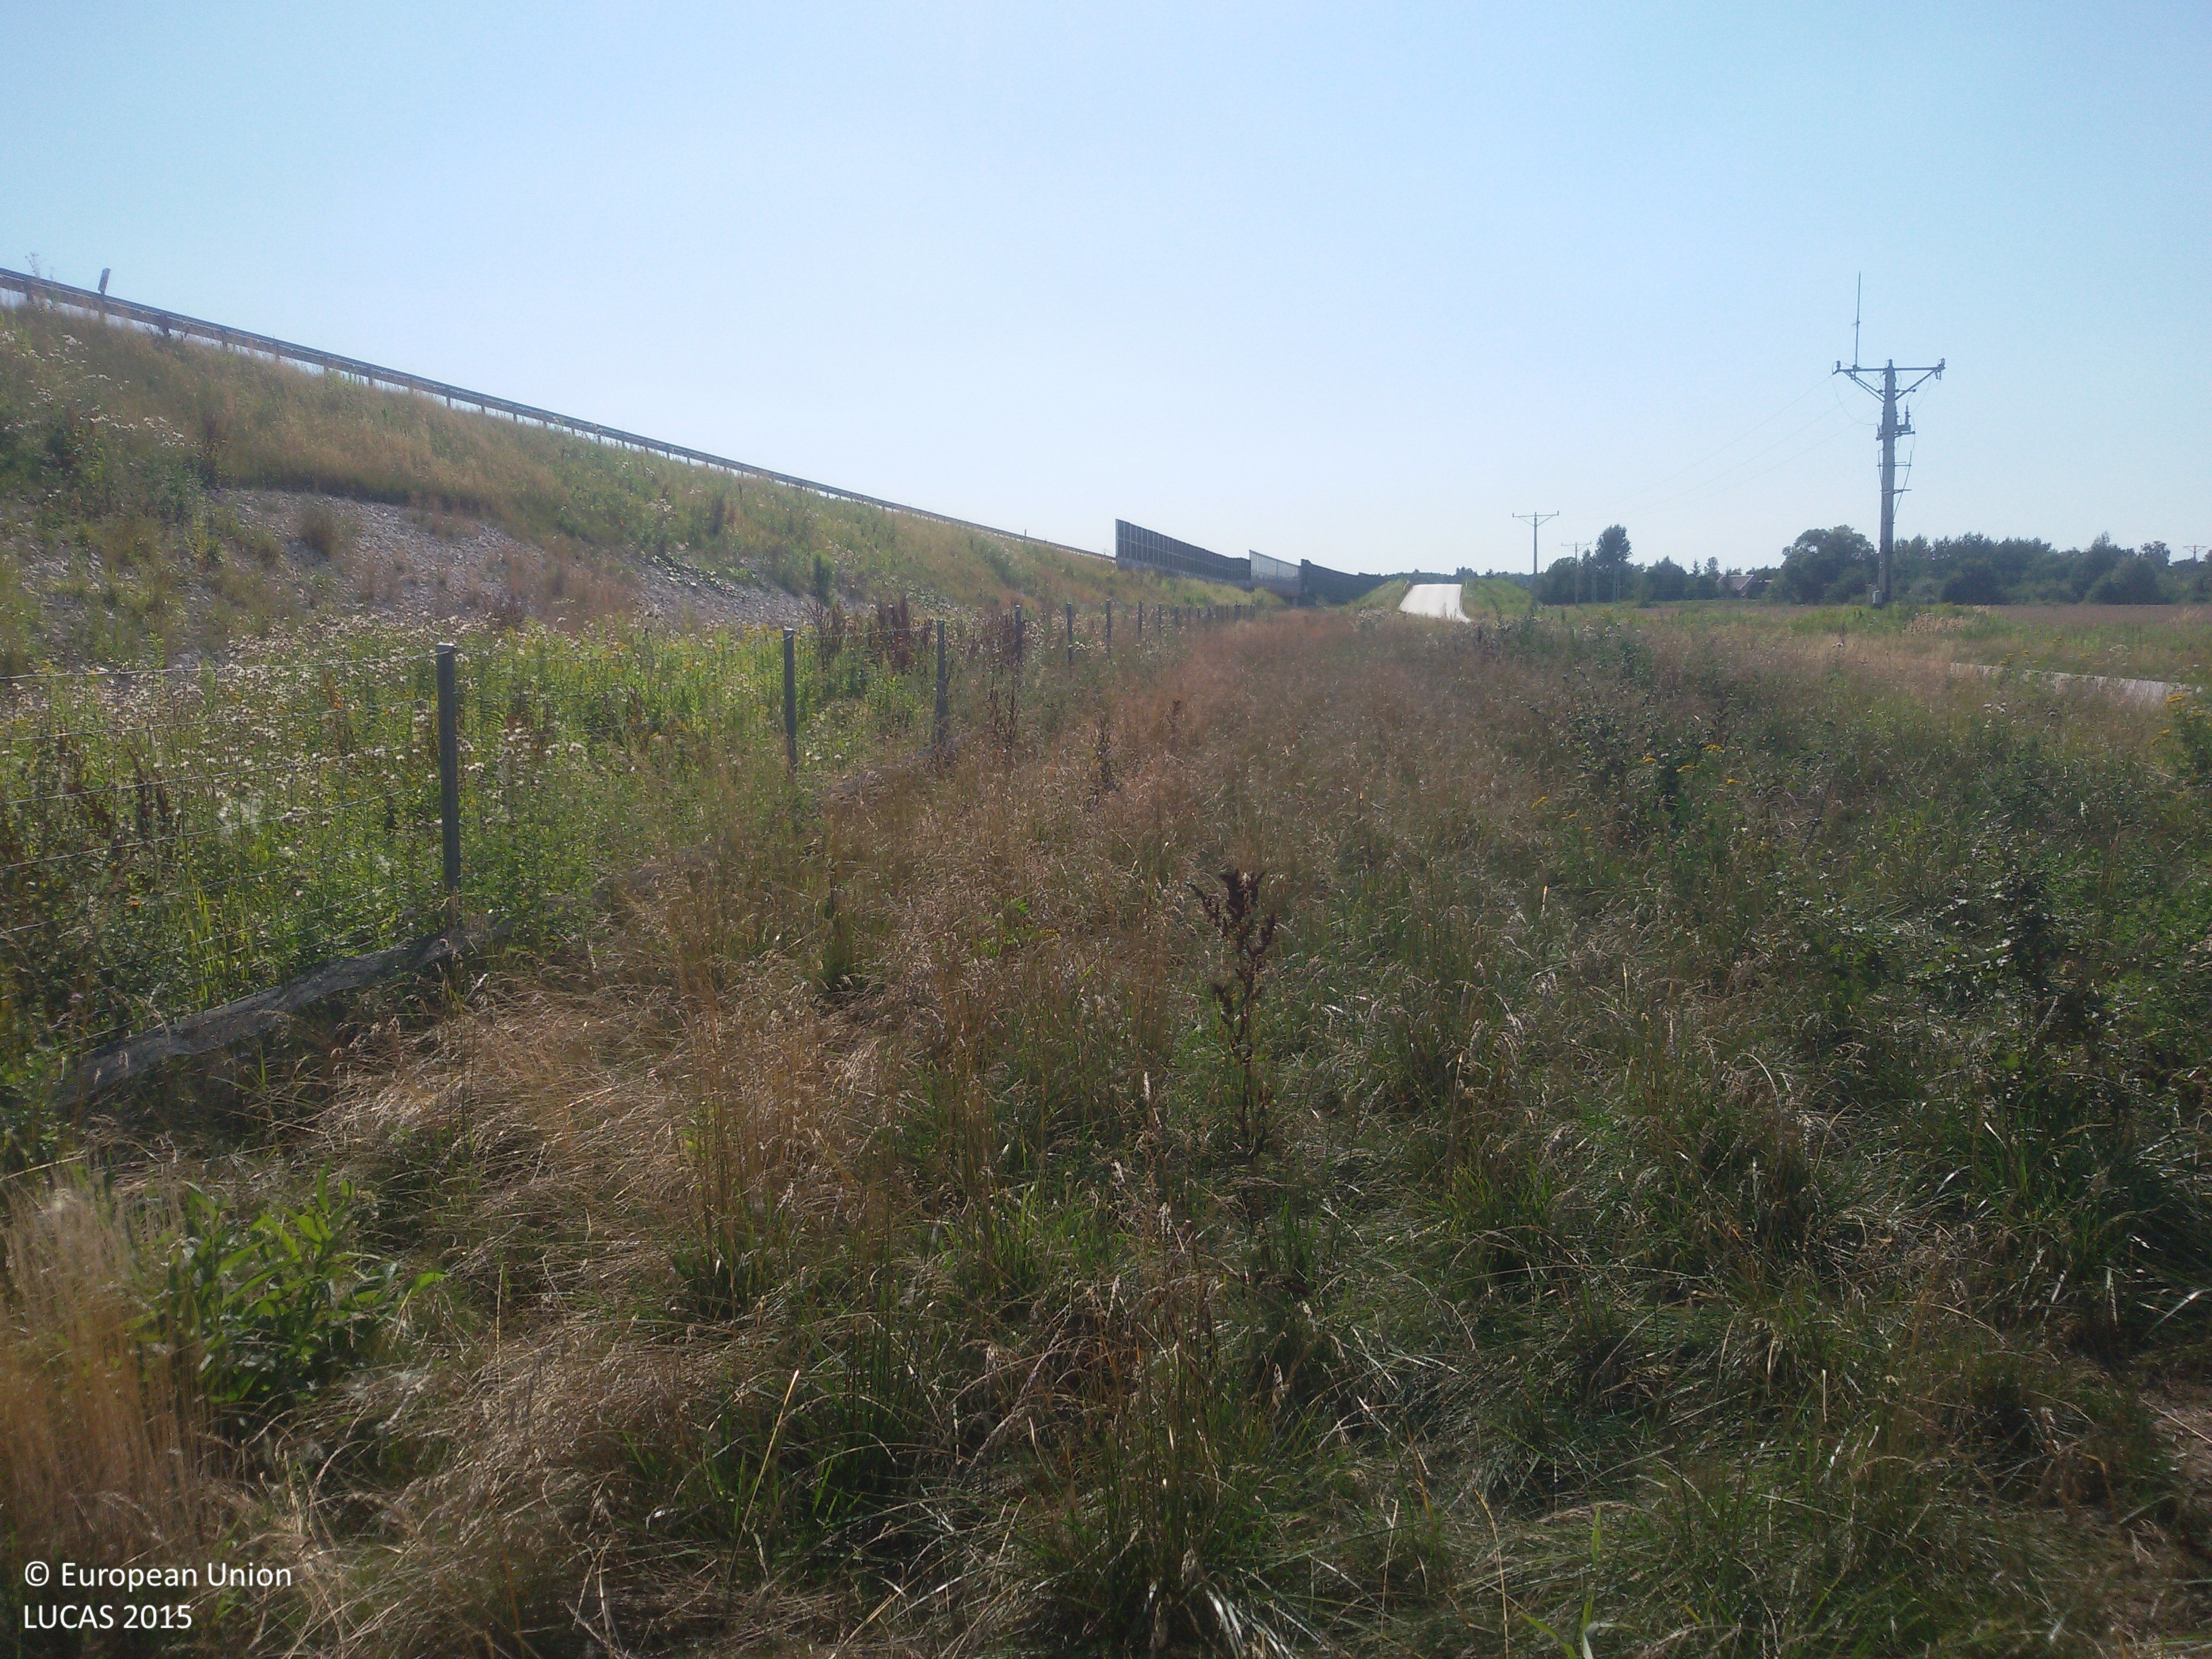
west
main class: Grassland
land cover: Grassland without tree/shrub cover
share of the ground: > 75 %
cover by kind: herbaceous plants 100 %
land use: Road transport
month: July
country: PL
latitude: 50.0044
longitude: 20.7137
